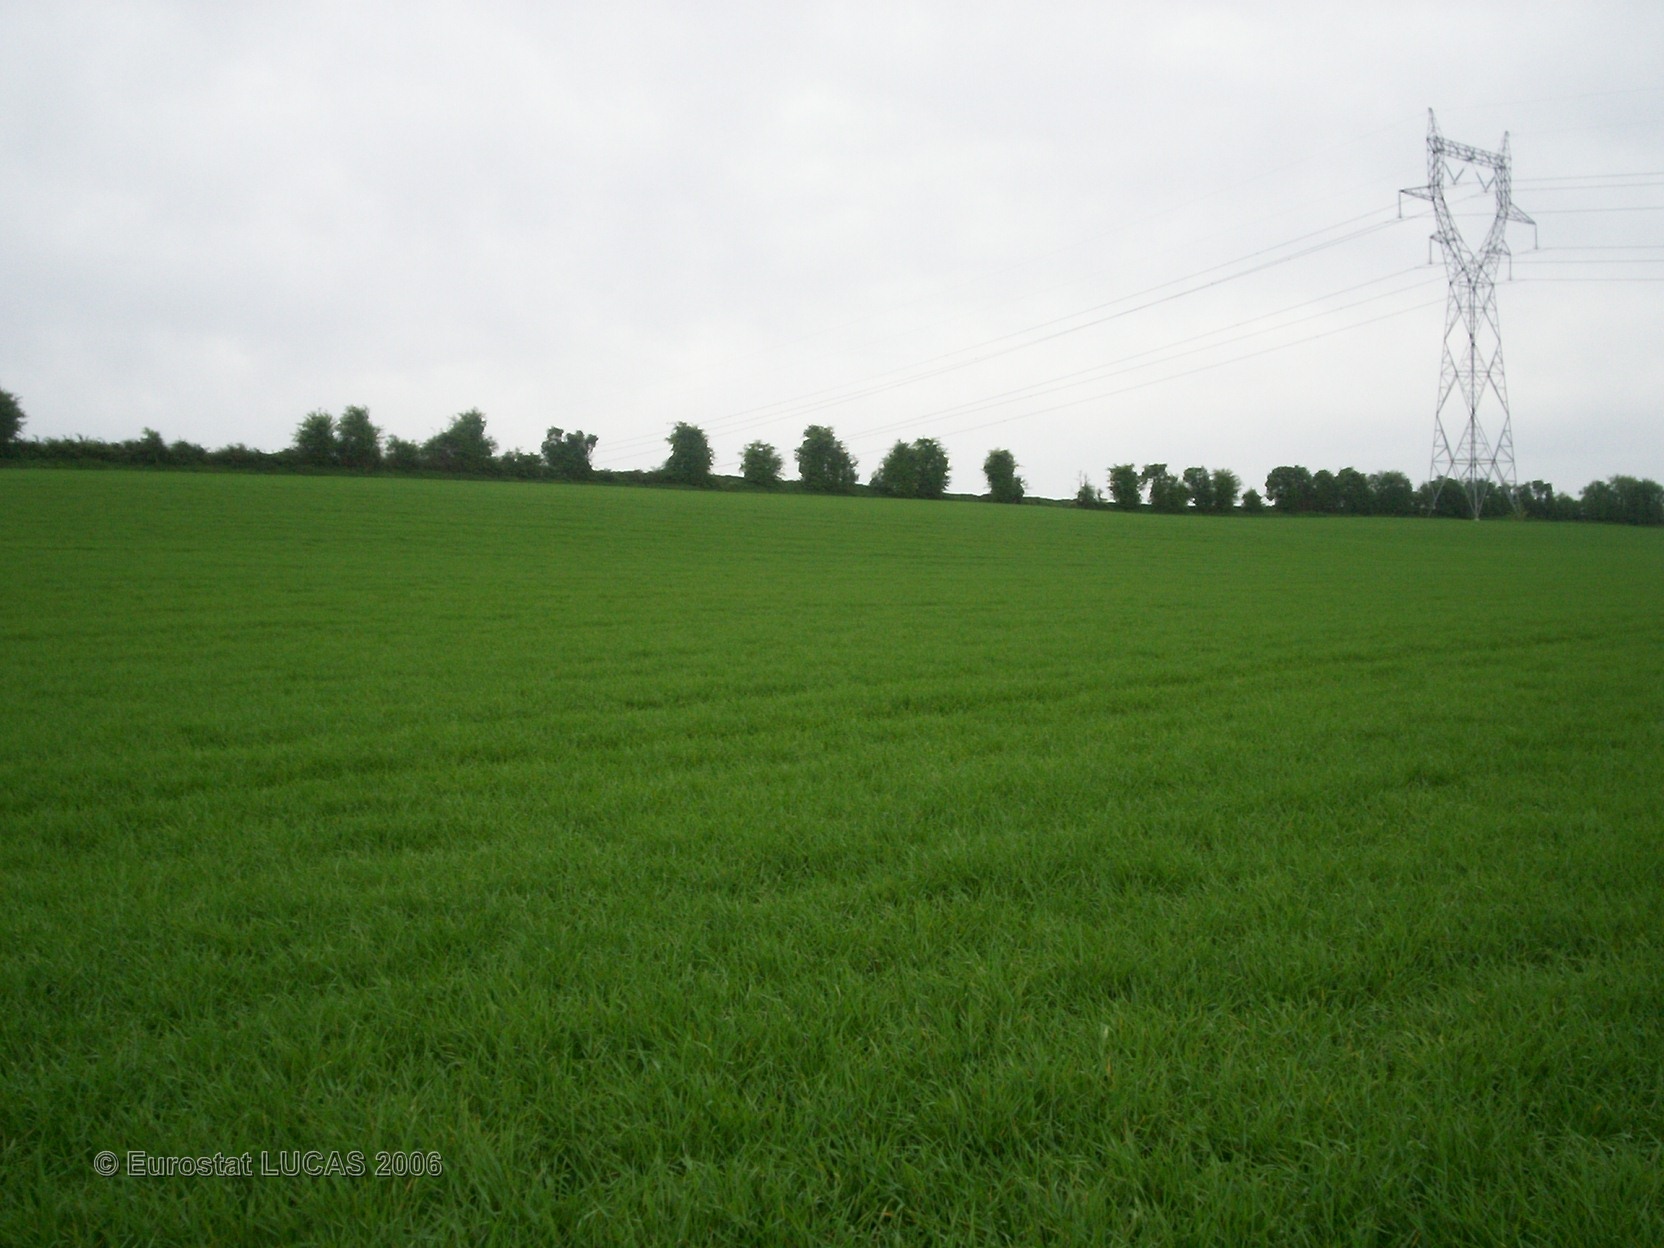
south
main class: Cropland
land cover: Barley
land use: Agriculture (excluding fallow land and kitchen gardens)
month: May
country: FR
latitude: 50.3004
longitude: 2.5329
